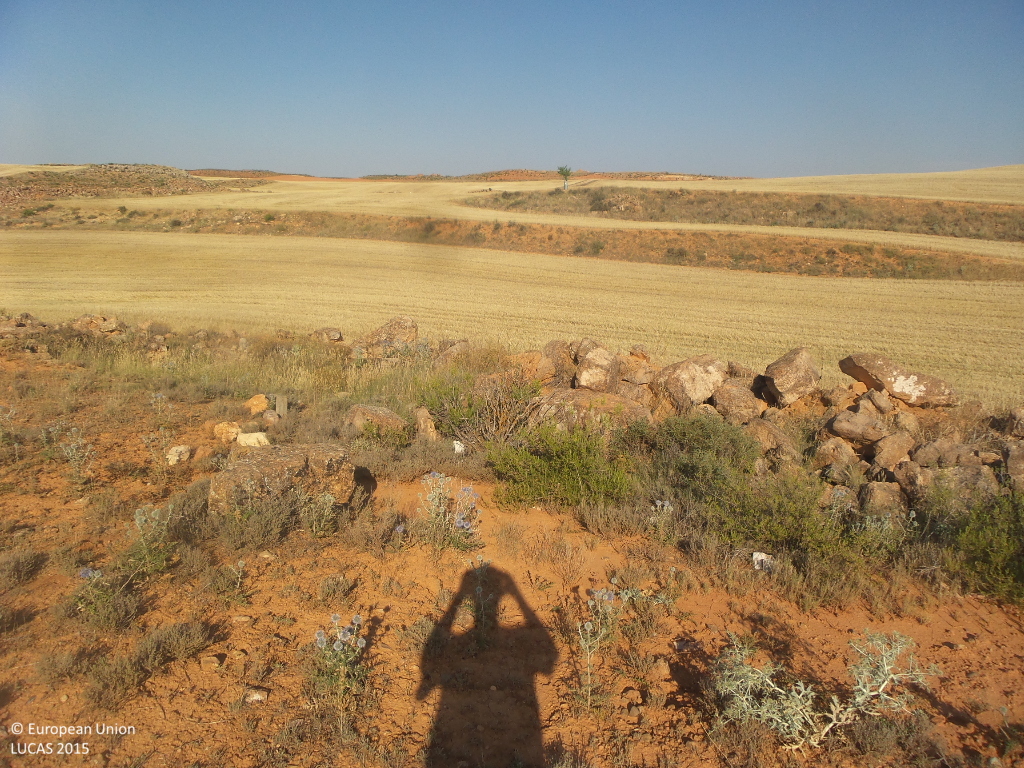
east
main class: Shrubland
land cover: Shrubland without tree cover
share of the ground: 50 - 75 %
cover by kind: shrubs 50 %, unconsolidated bare surface 40 %, herbaceous plants 10 %
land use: Semi-natural and natural areas not in use
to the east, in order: Shrubland without tree cover; Common wheat; Shrubland without tree cover; Common wheat; Dry stone walls; Grass margins; Tracks; Grass margins; Barley
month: July
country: ES
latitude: 41.2485
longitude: -2.1173
